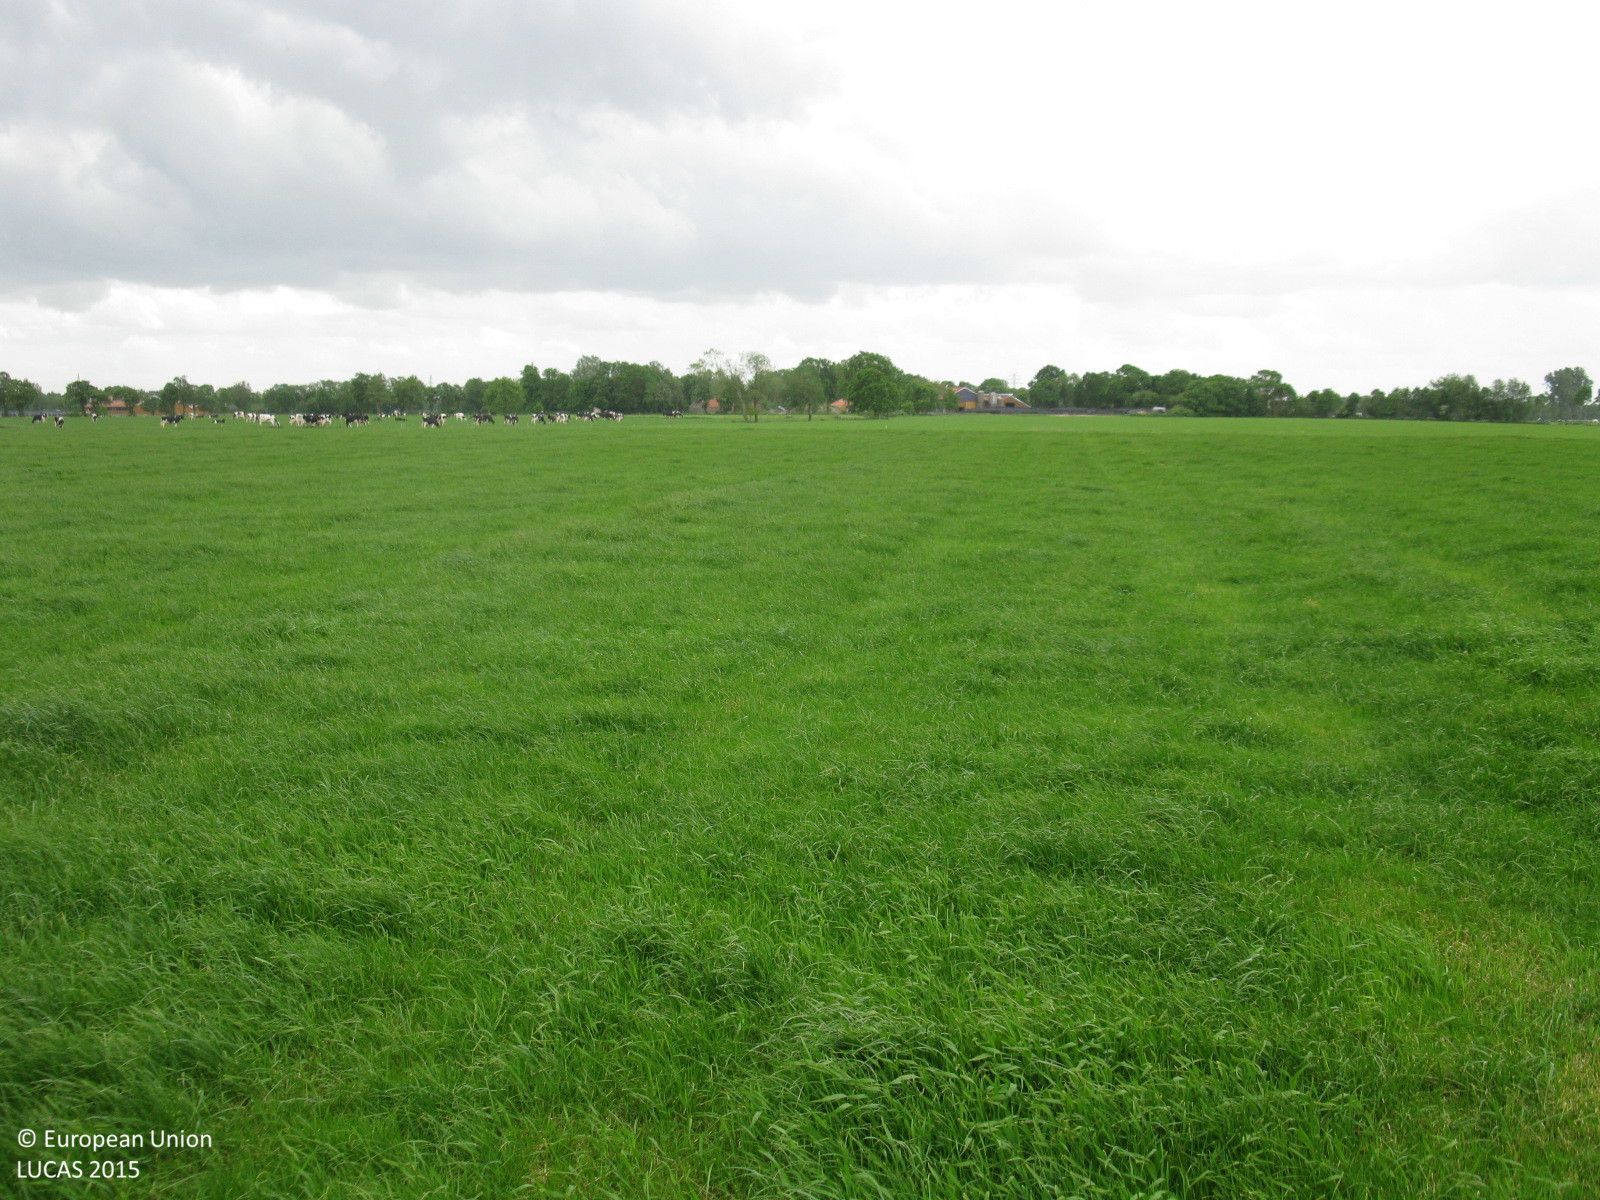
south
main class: Grassland
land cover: Grassland without tree/shrub cover
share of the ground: > 75 %
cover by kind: herbaceous plants 100 %
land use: Agriculture (excluding fallow land and kitchen gardens)
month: June
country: DE
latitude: 53.1220
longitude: 7.3856
